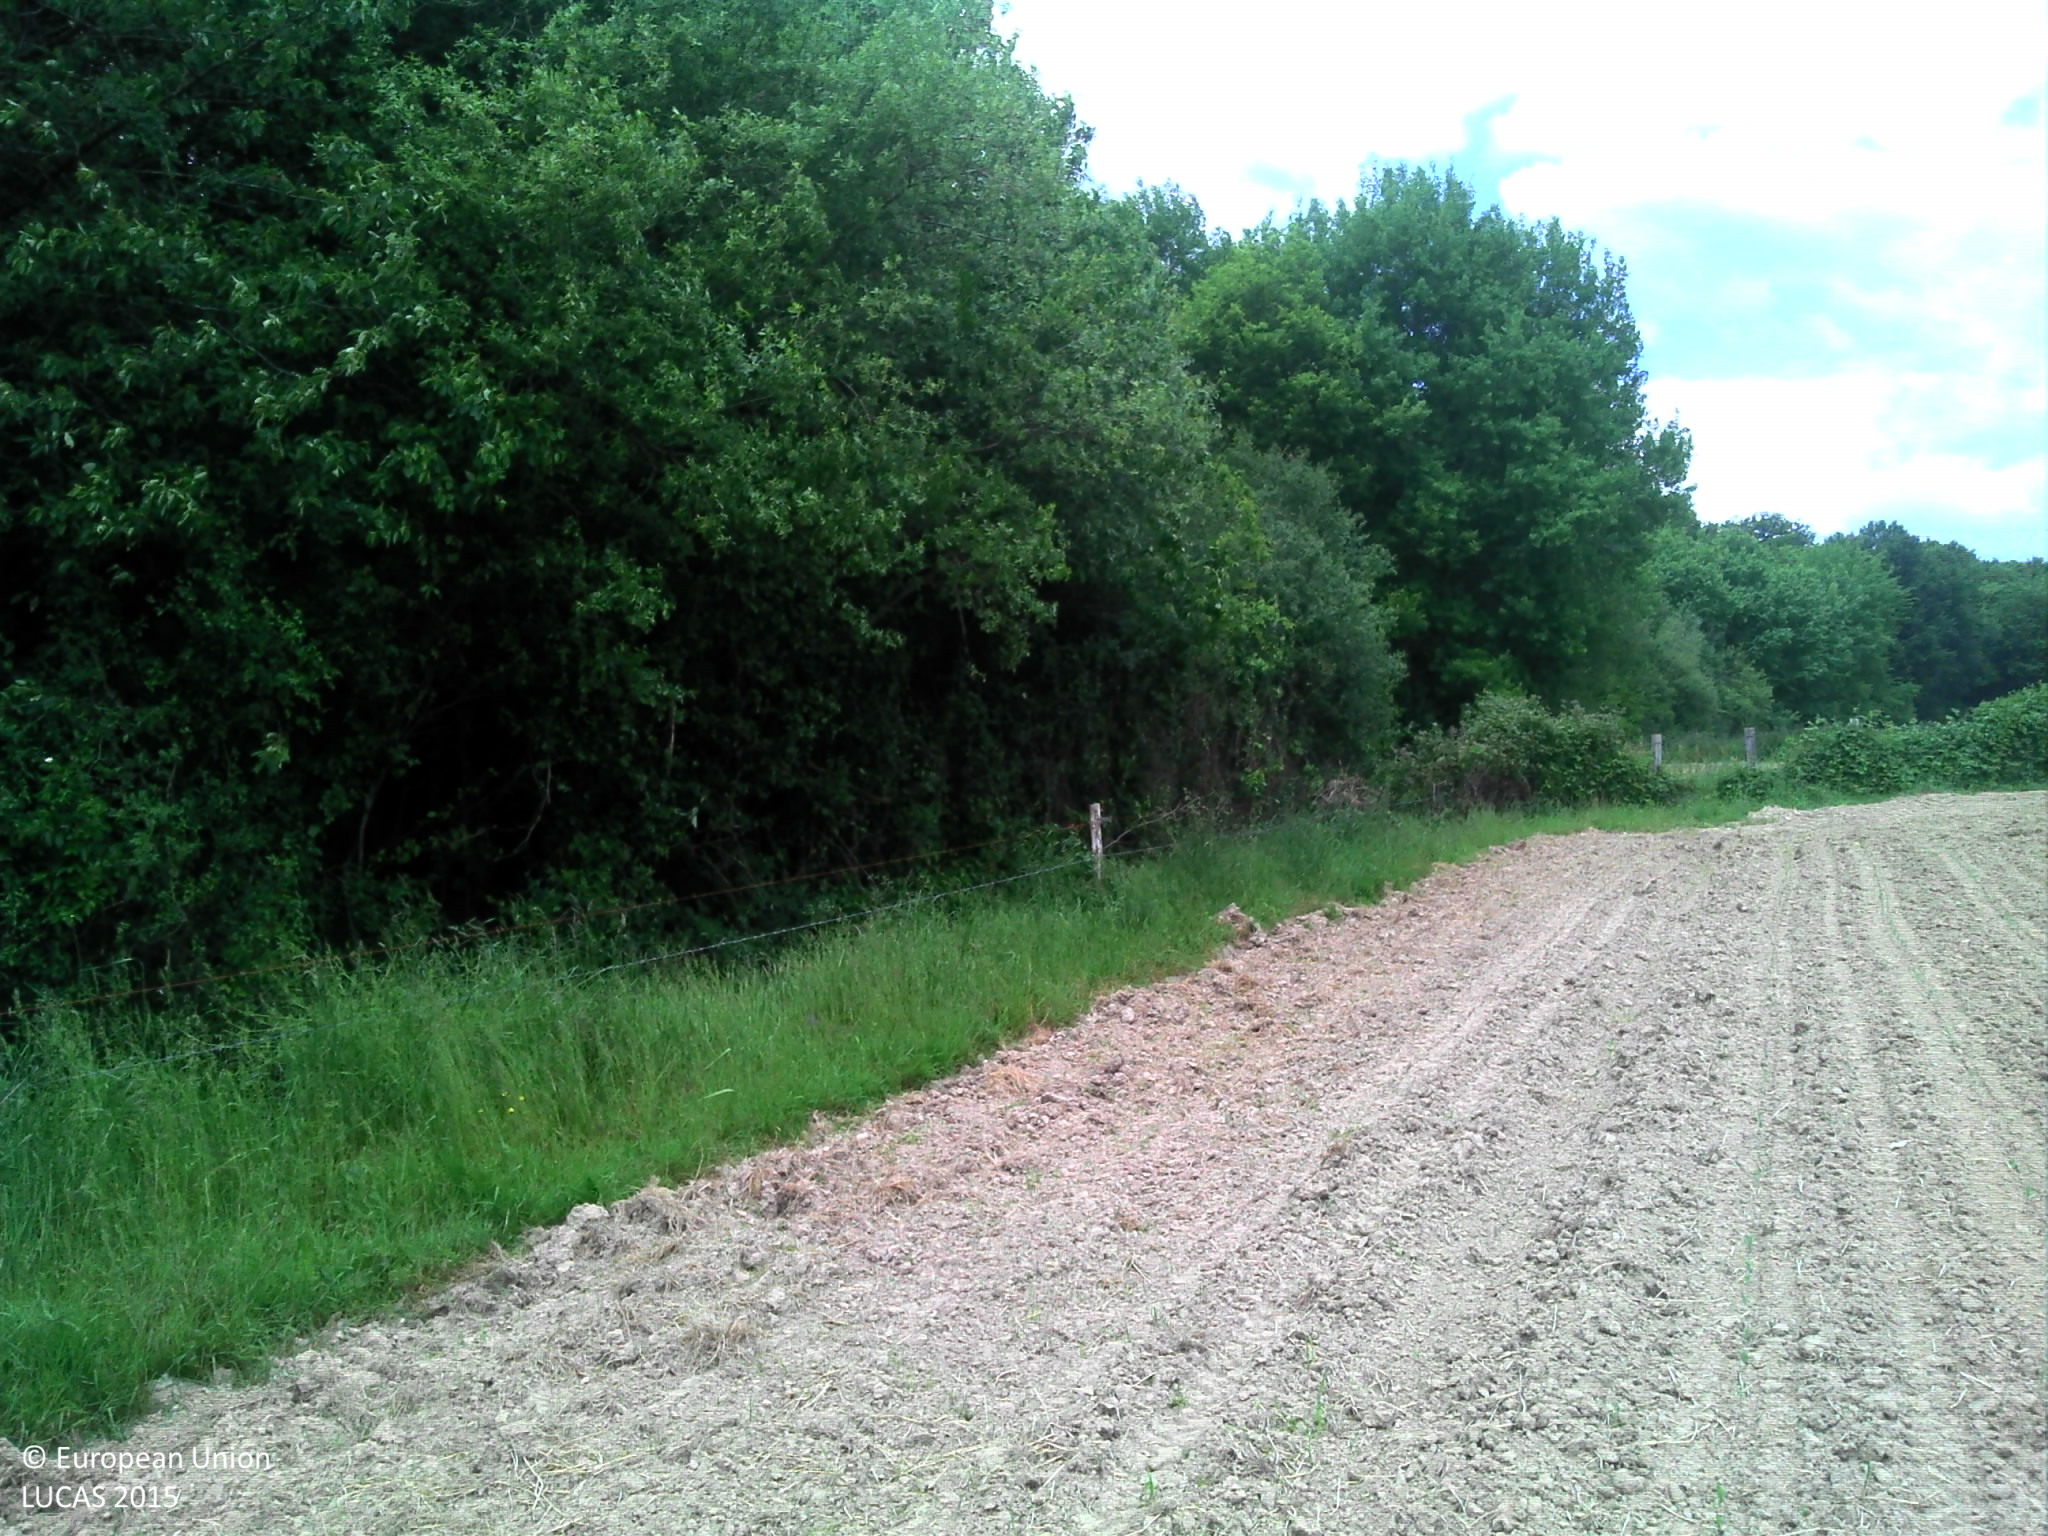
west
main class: Woodland
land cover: Broadleaved woodland
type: mesophytic deciduous forest
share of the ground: > 75 %
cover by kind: broadleaved forest trees 90 %, herbaceous plants 5 %, lichens and mosses 5 %
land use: Forestry
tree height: > 5 m
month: May
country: FR
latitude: 47.6353
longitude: 0.7568
